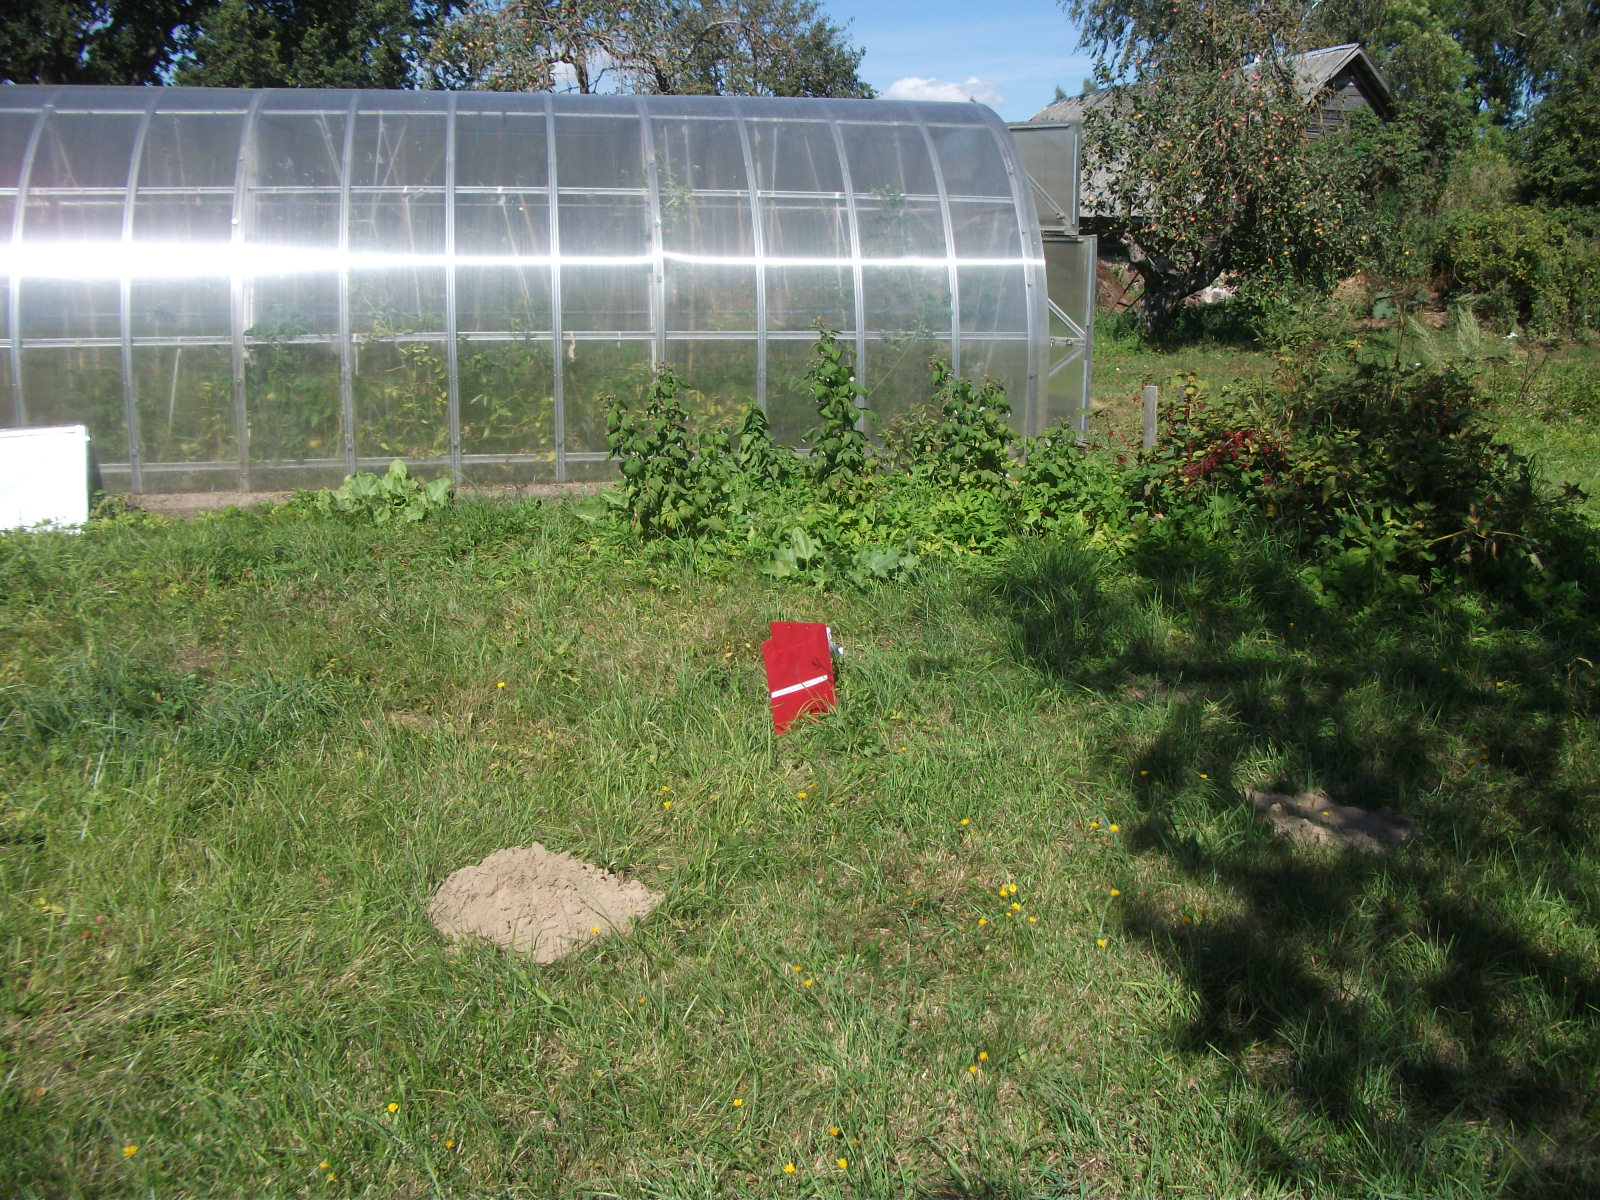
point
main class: Cropland
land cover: Apple fruit
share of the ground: 10 - 25 %
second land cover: Grassland without tree/shrub cover
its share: > 75 %
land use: Kitchen garden
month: August
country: LV
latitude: 56.4539
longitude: 26.0526
